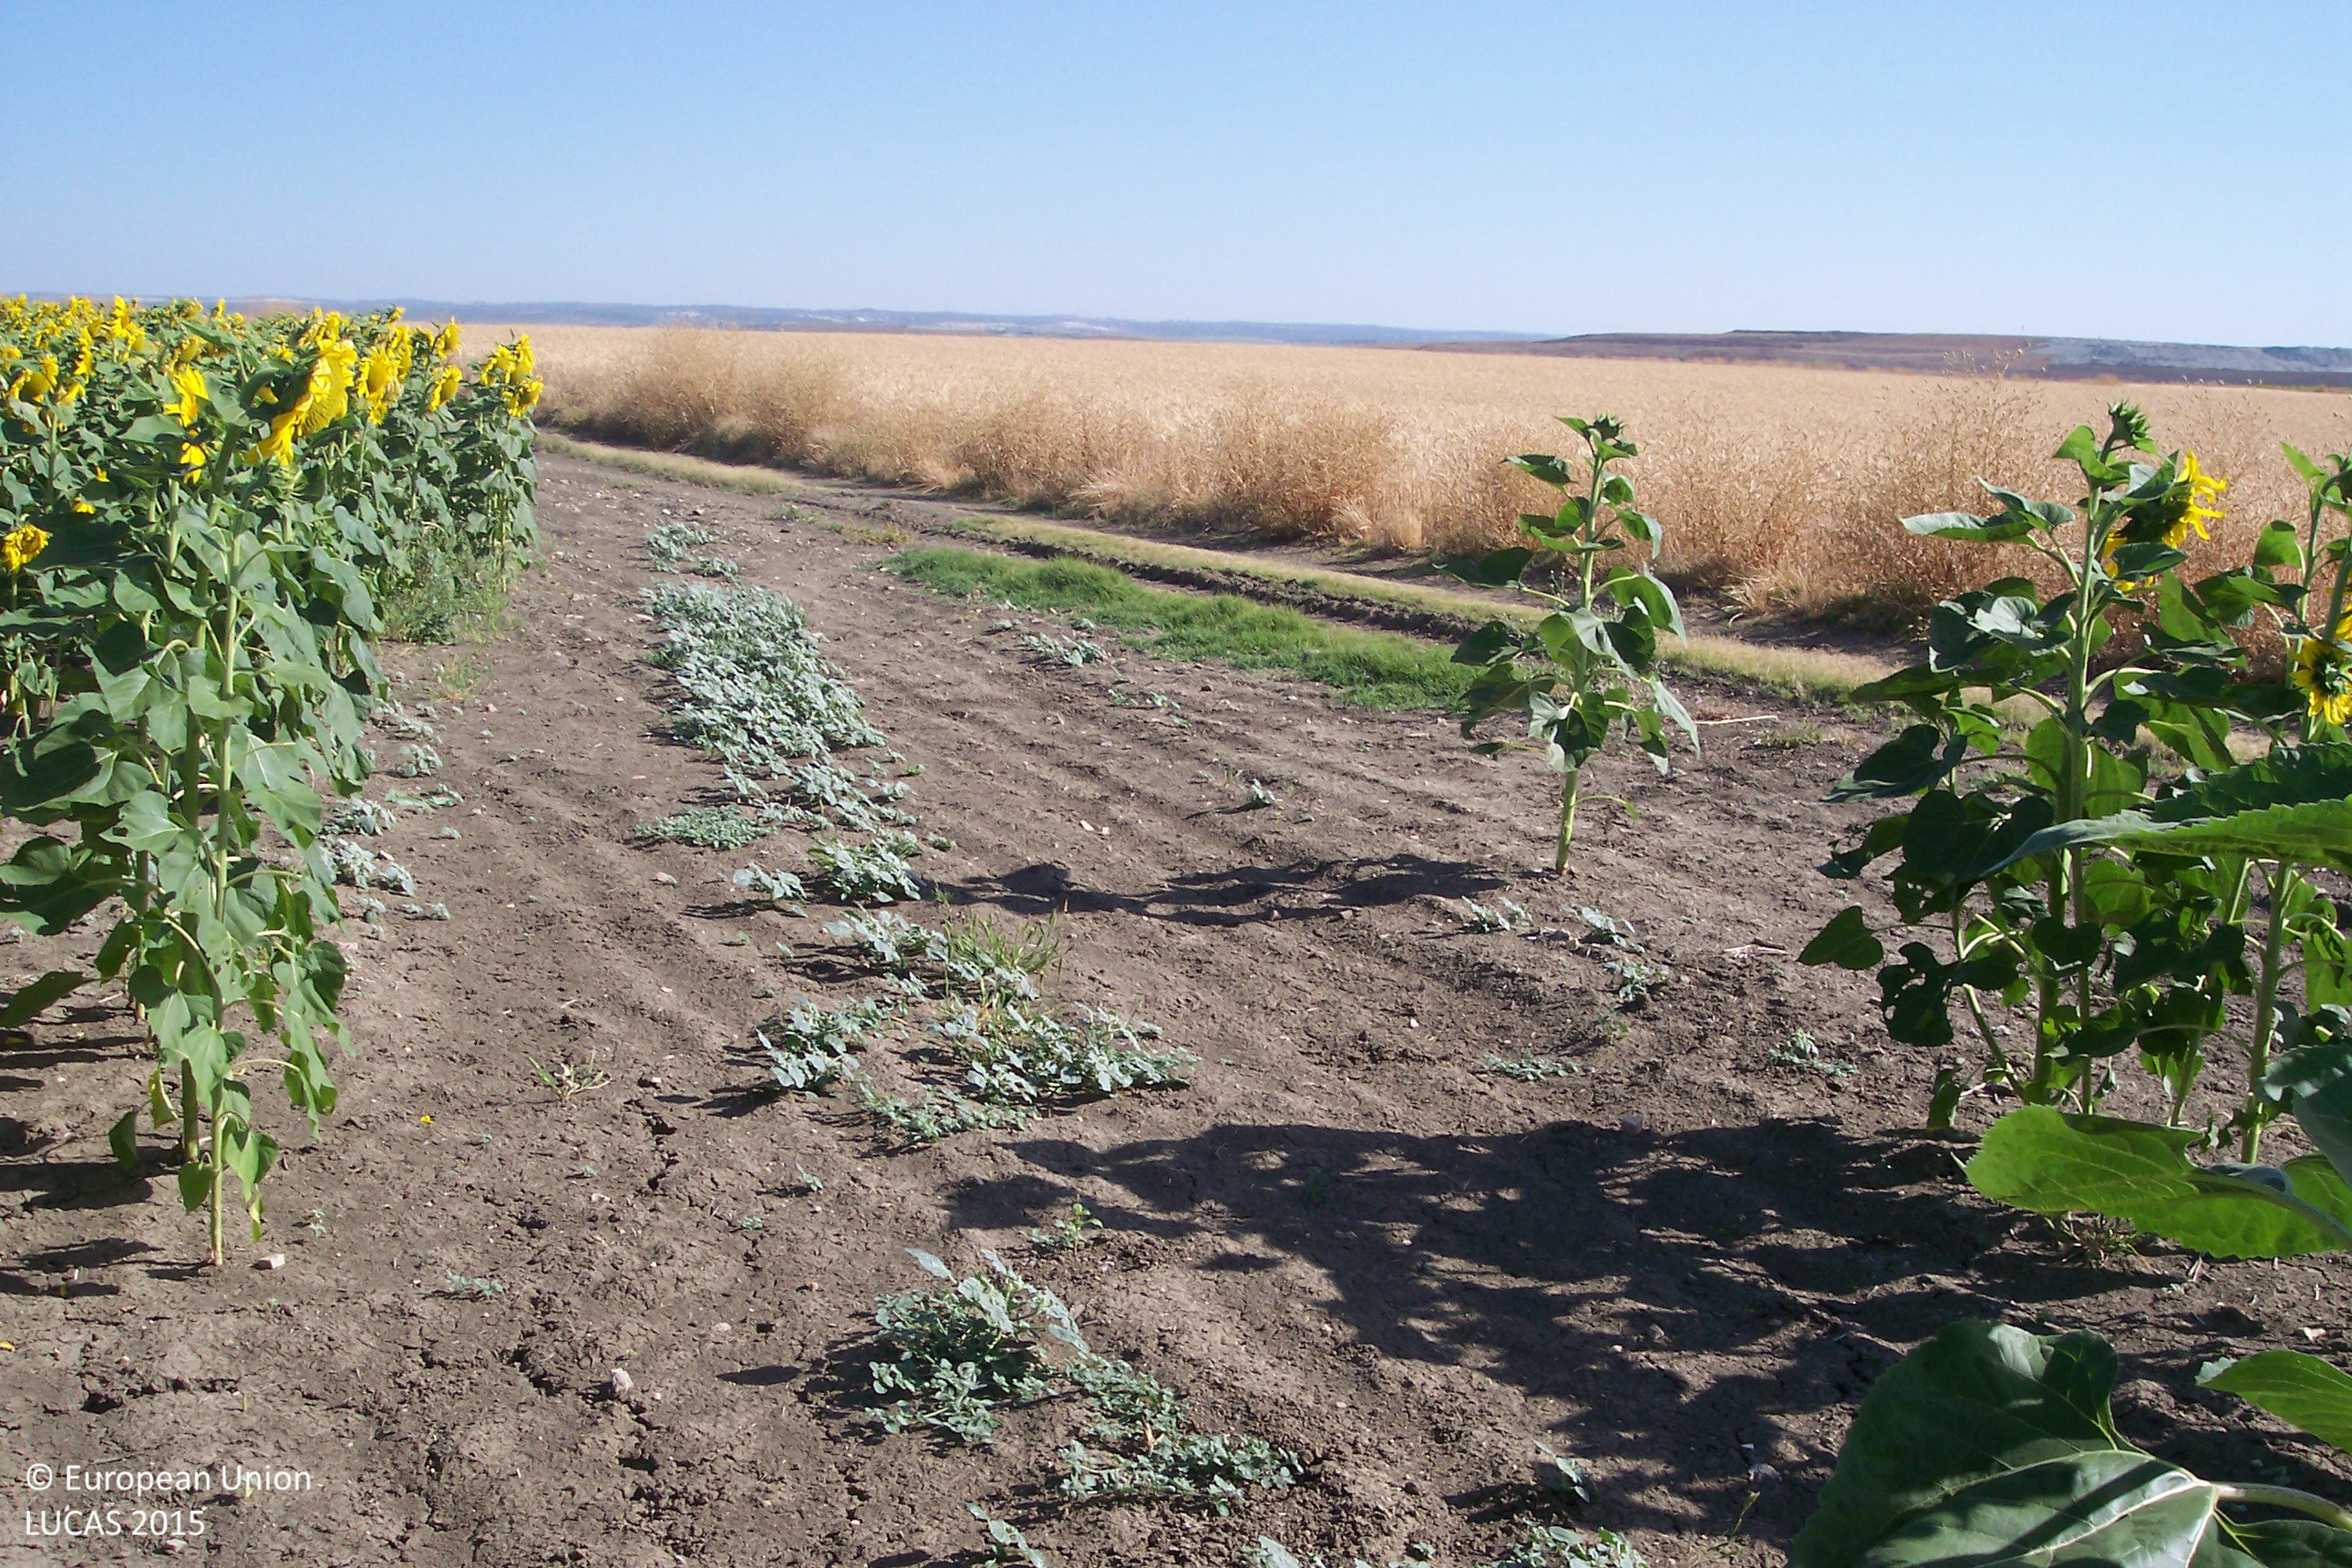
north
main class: Cropland
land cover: Sunflower
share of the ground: > 75 %
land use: Agriculture (excluding fallow land and kitchen gardens)
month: June
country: ES
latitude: 37.4733
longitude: -6.0950
